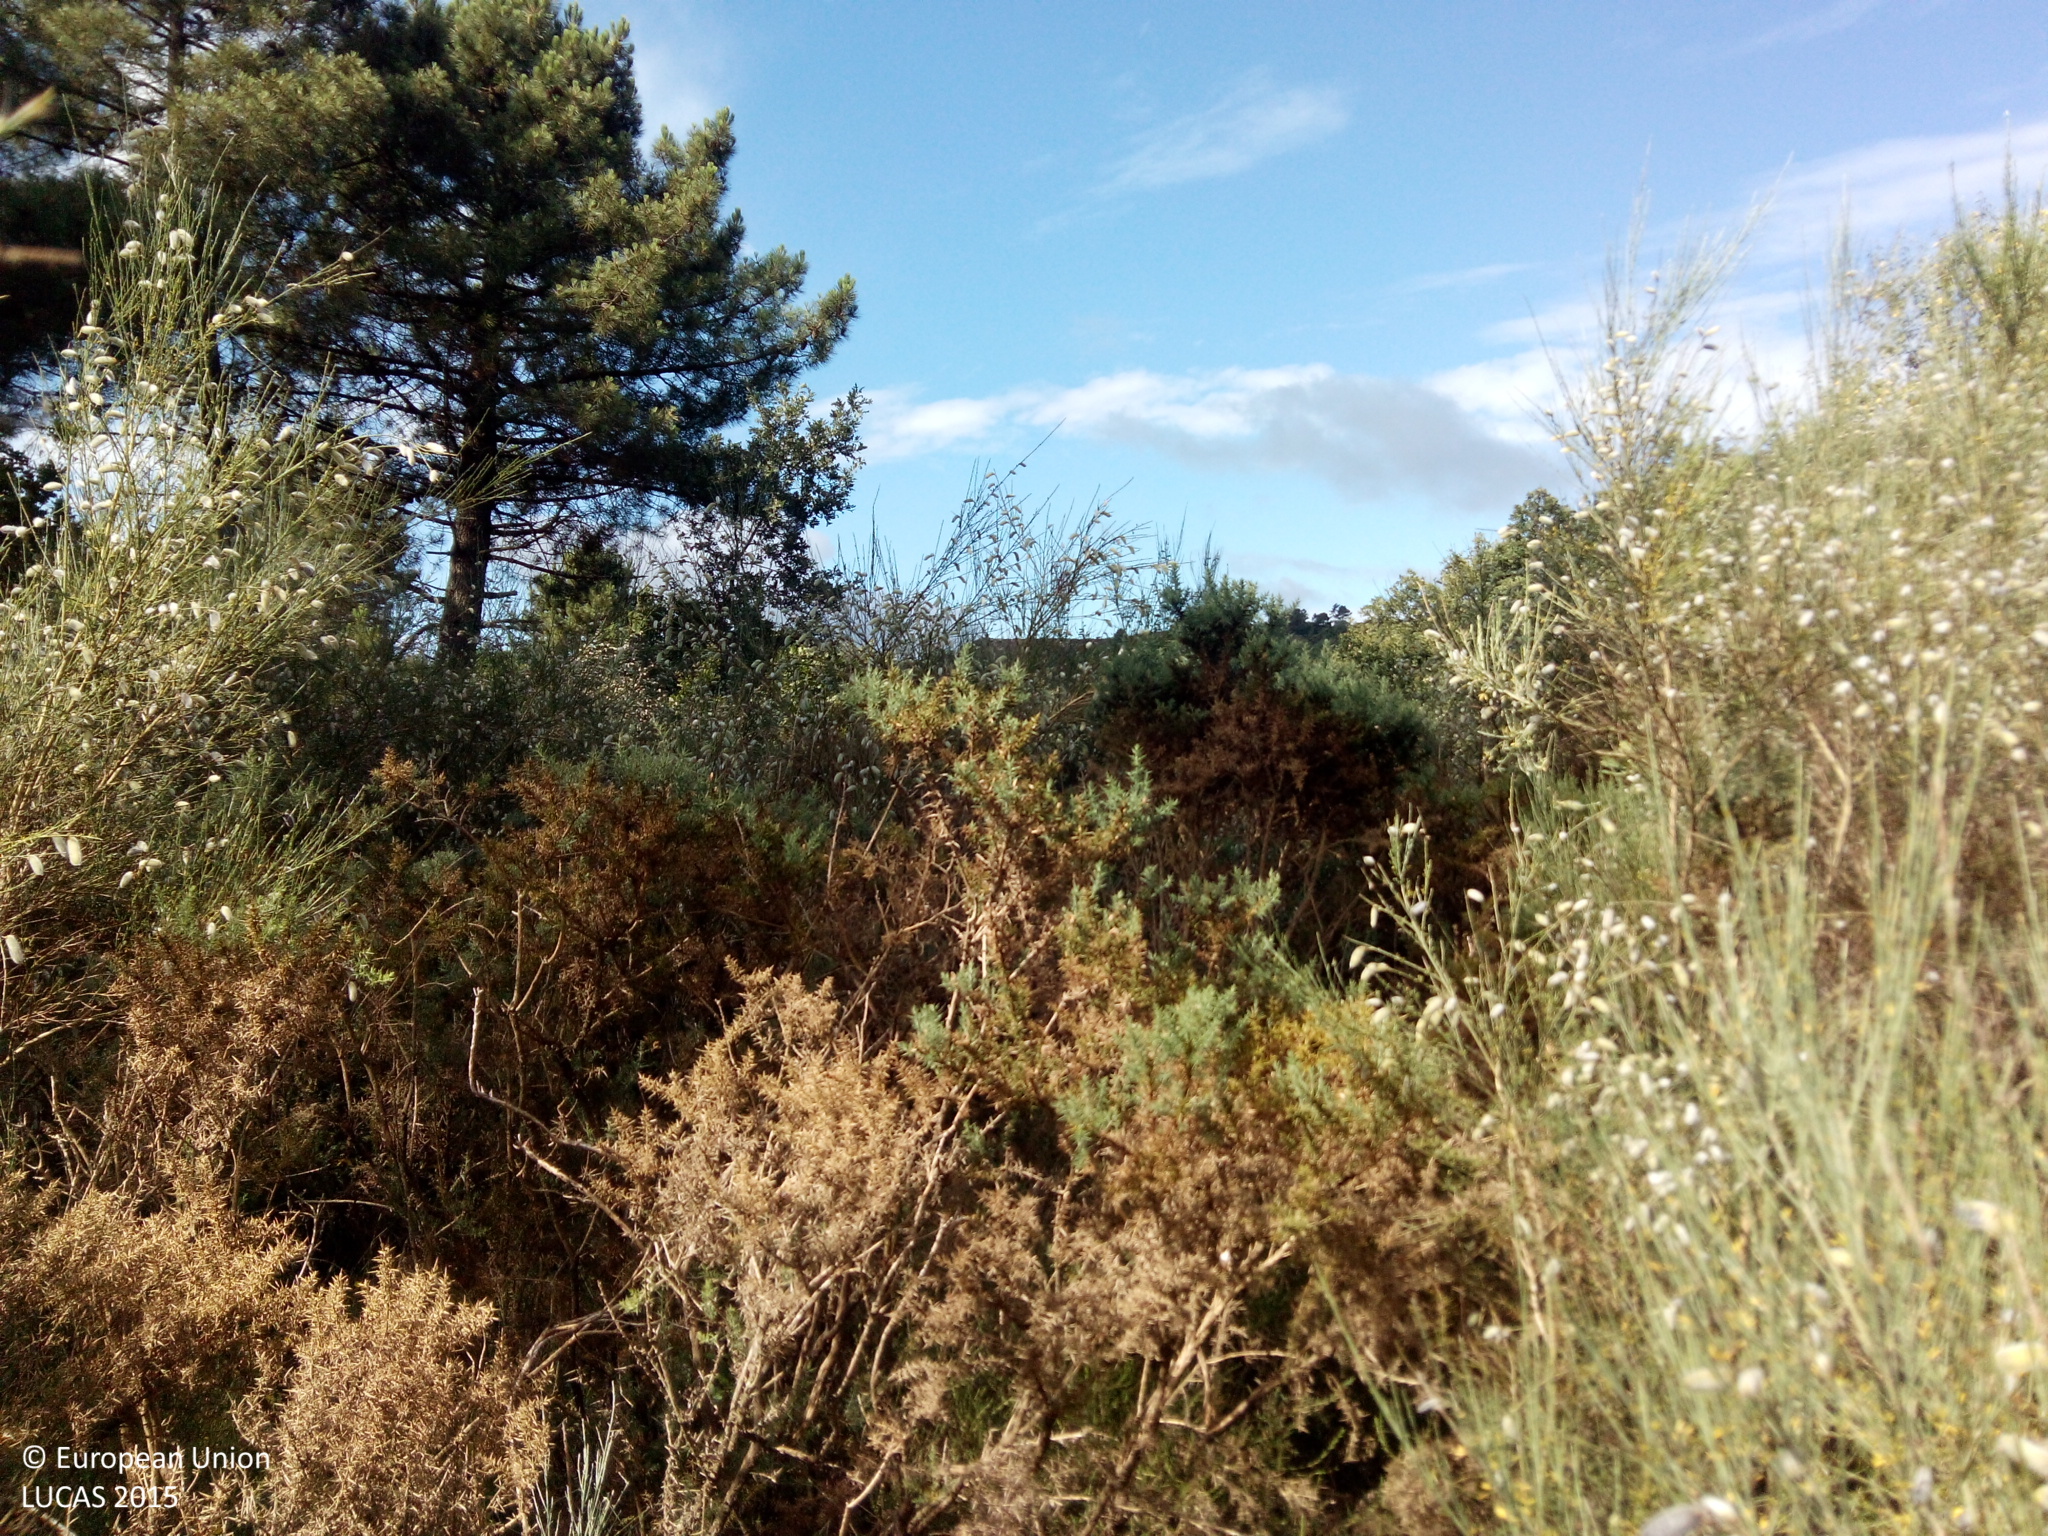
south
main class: Woodland
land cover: Other mixed woodland
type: acidophilous oak and oak-birch forest
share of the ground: > 75 %
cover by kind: shrubs 75 %, broadleaved forest trees 15 %, coniferous forest trees 10 %
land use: Abandoned areas
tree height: > 5 m
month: July
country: ES
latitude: 42.3615
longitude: -8.2653
